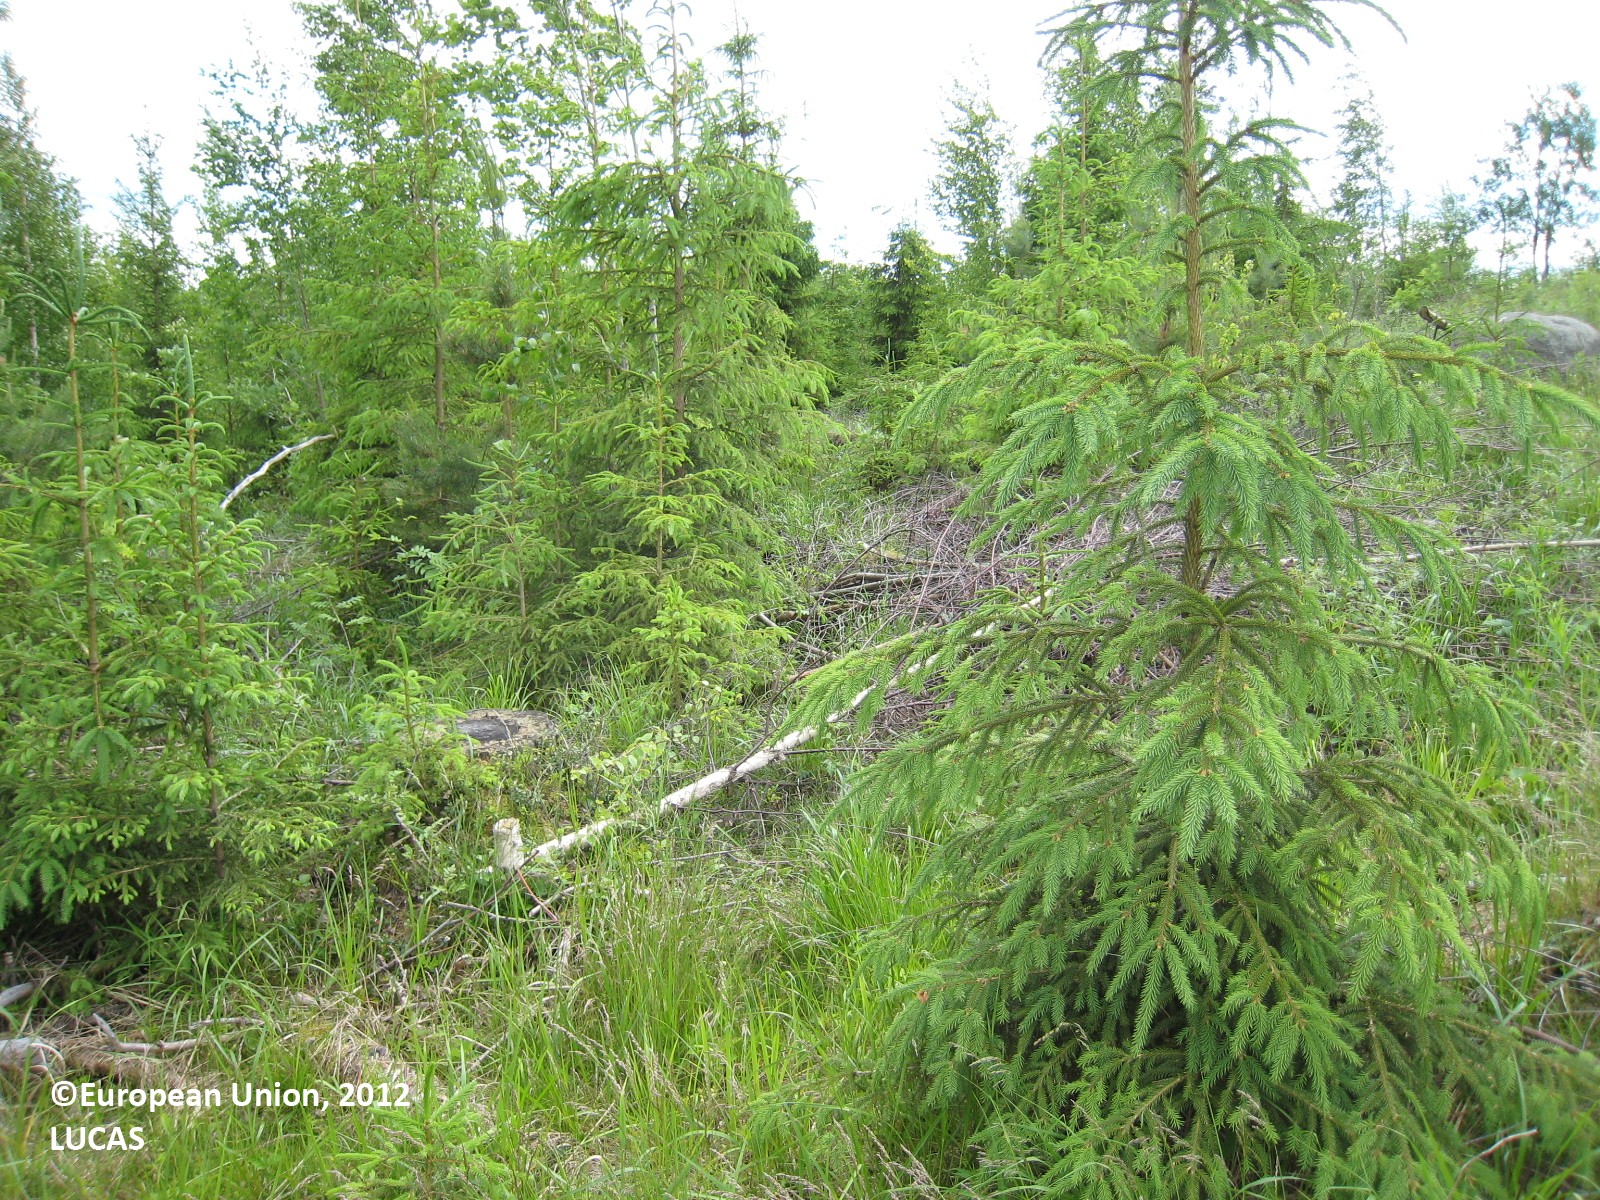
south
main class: Grassland
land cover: Grassland with sparse tree/shrub cover
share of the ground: > 75 %
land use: Forestry
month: June
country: FI
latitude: 62.1434
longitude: 26.2686
